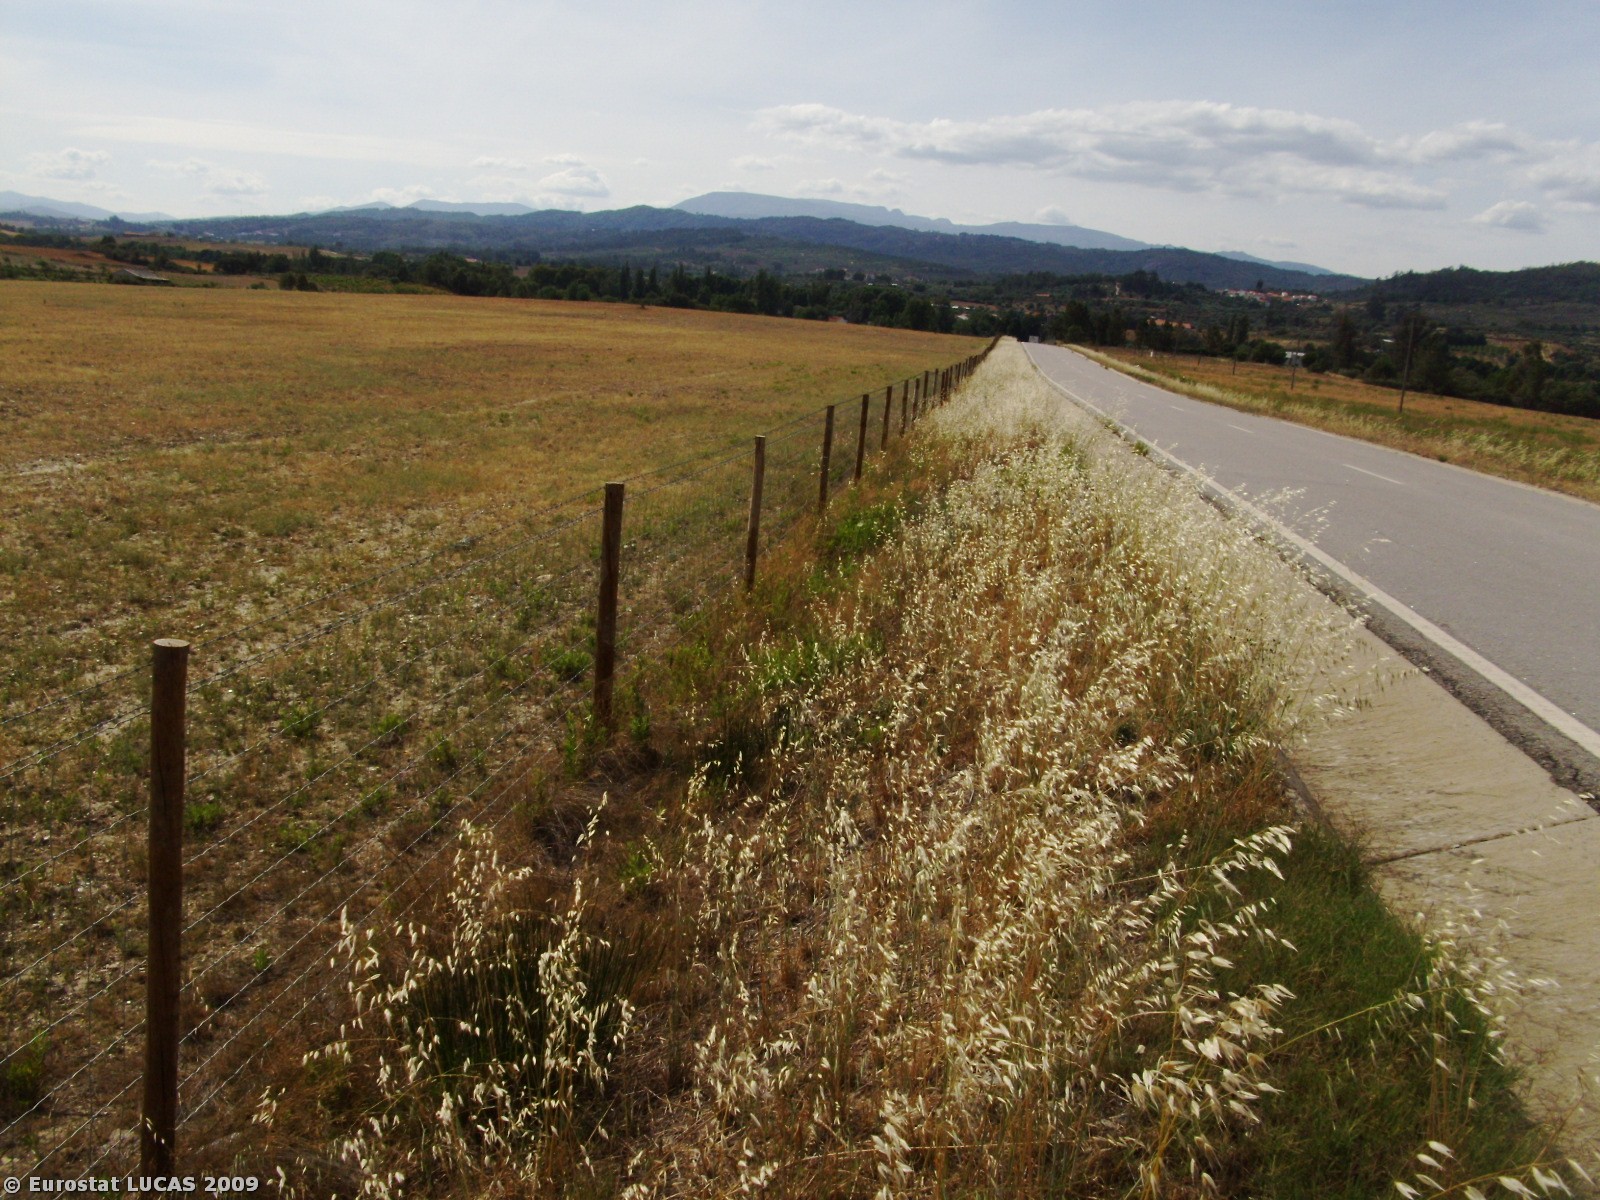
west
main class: Grassland
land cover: Spontaneously vegetated surfaces
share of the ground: > 75 %
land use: Fallow land
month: June
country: PT
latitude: 40.1834
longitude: -7.3550
